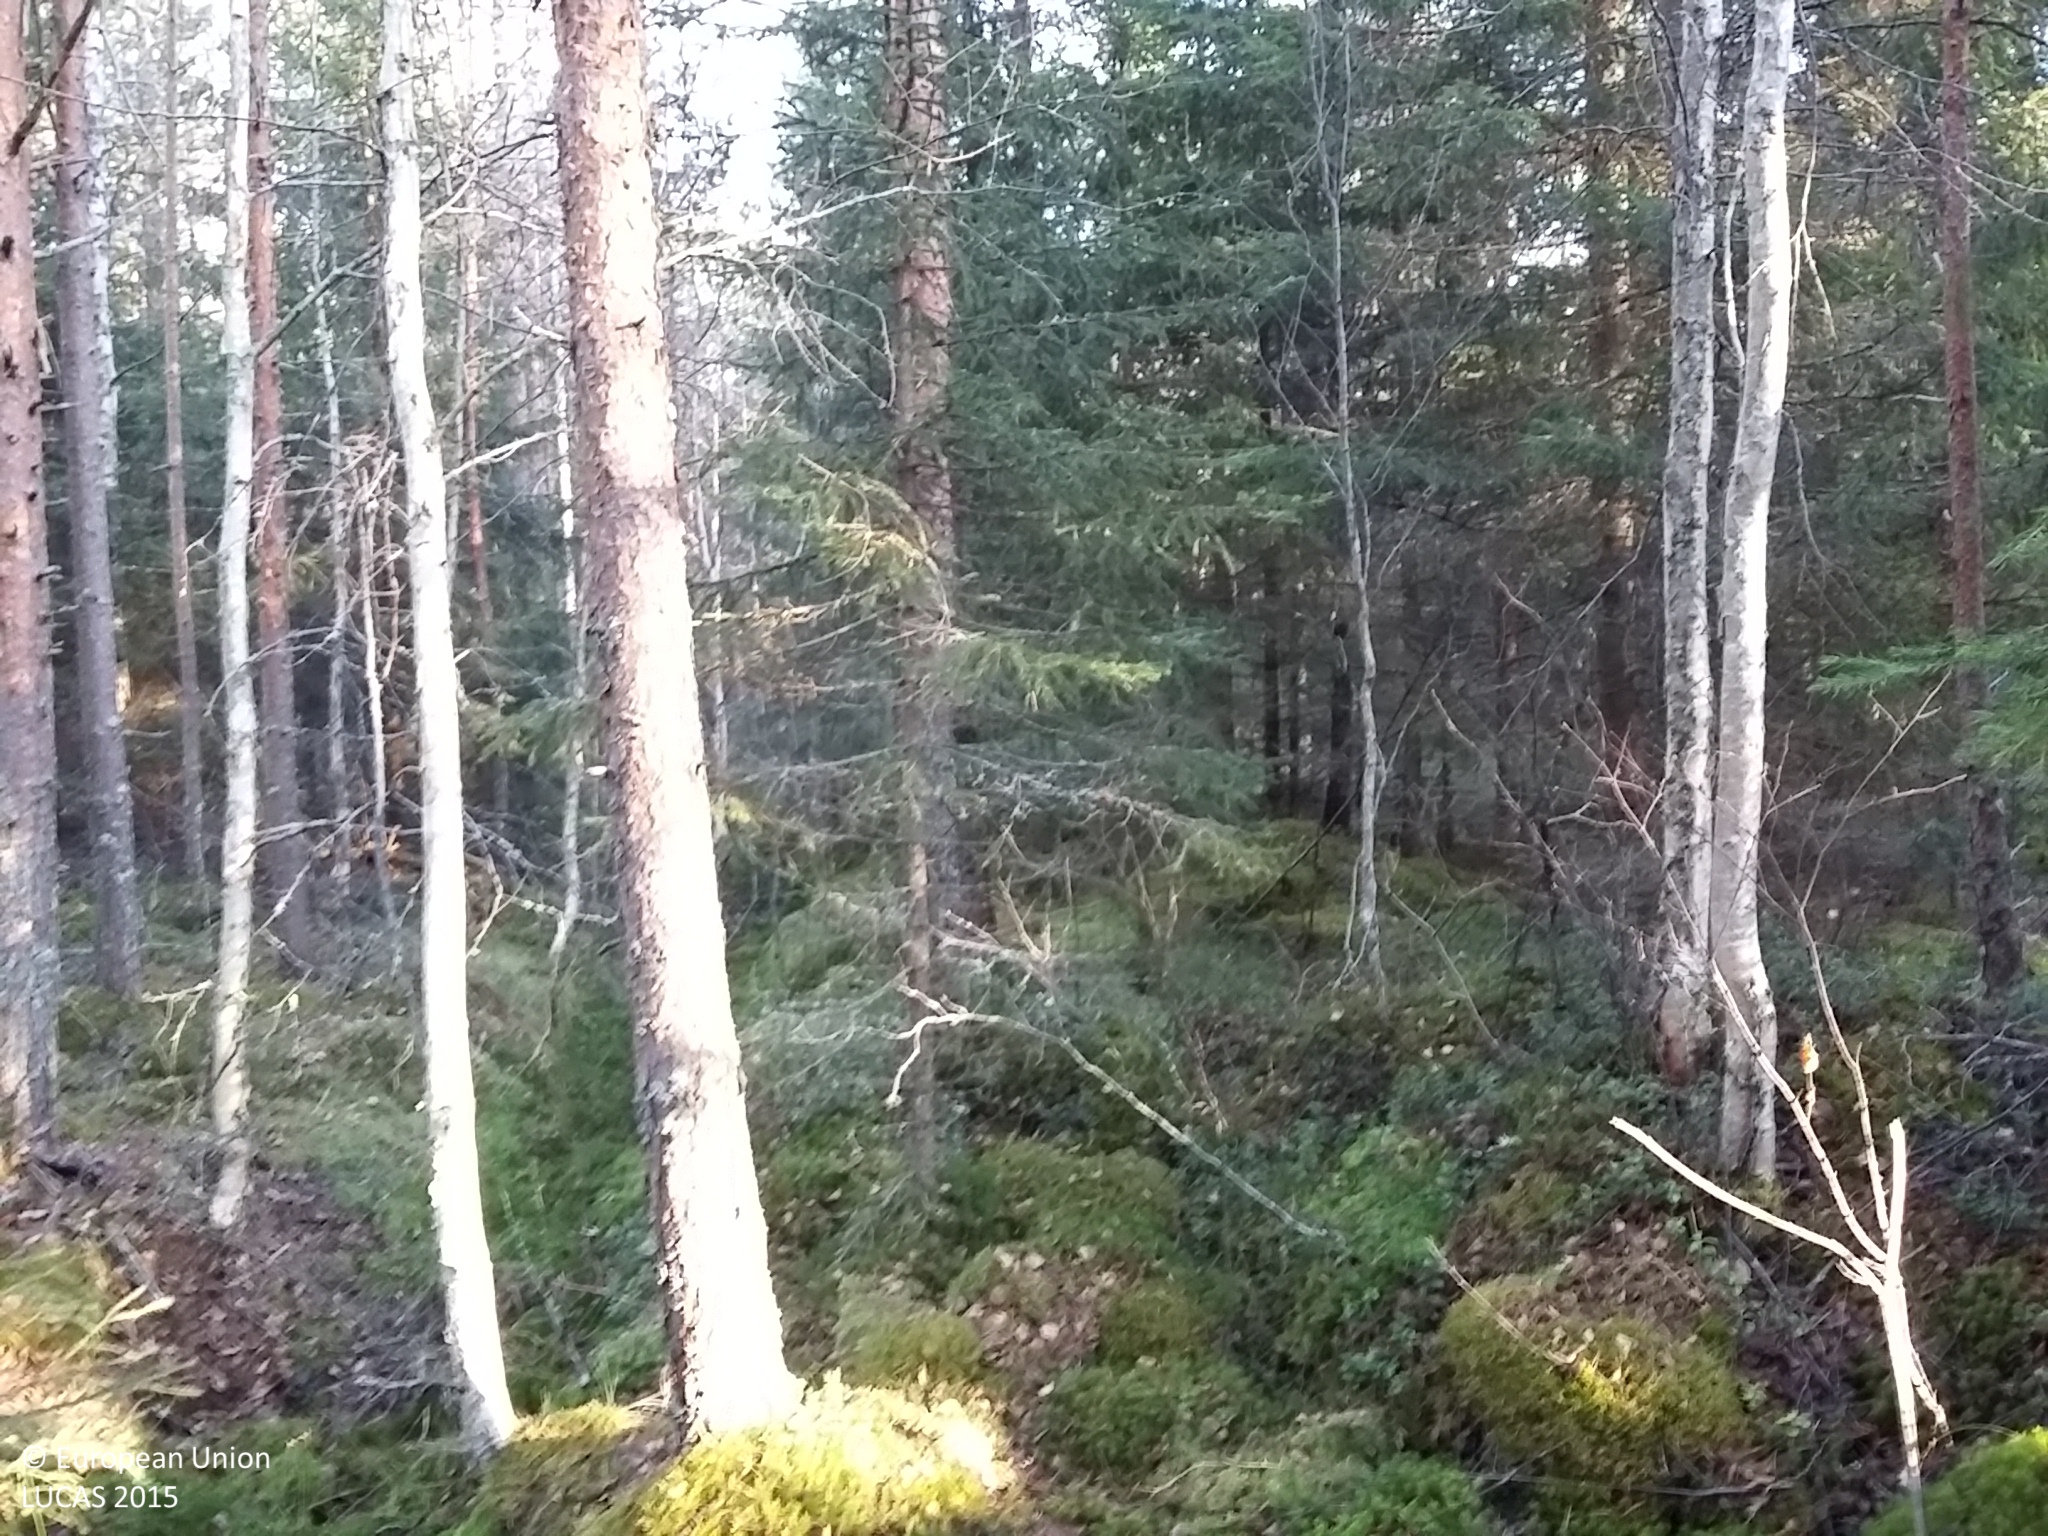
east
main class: Woodland
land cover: Other coniferous woodland
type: boreal forest
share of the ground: > 75 %
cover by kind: coniferous forest trees 80 %, broadleaved forest trees 10 %, herbaceous plants 5 %, lichens and mosses 5 %
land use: Forestry
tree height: > 5 m
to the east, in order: Other coniferous woodland; Pine dominated coniferous woodland; Ditches and canals; Grass margins; Spontaneously vegetated surfaces; Grass margins; Ditches and canals; Grass margins; Spontaneously vegetated surfaces; Shruby margins; Ditches and canals; Shruby margins; Oats
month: October
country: FI
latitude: 64.5928
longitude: 25.4839
